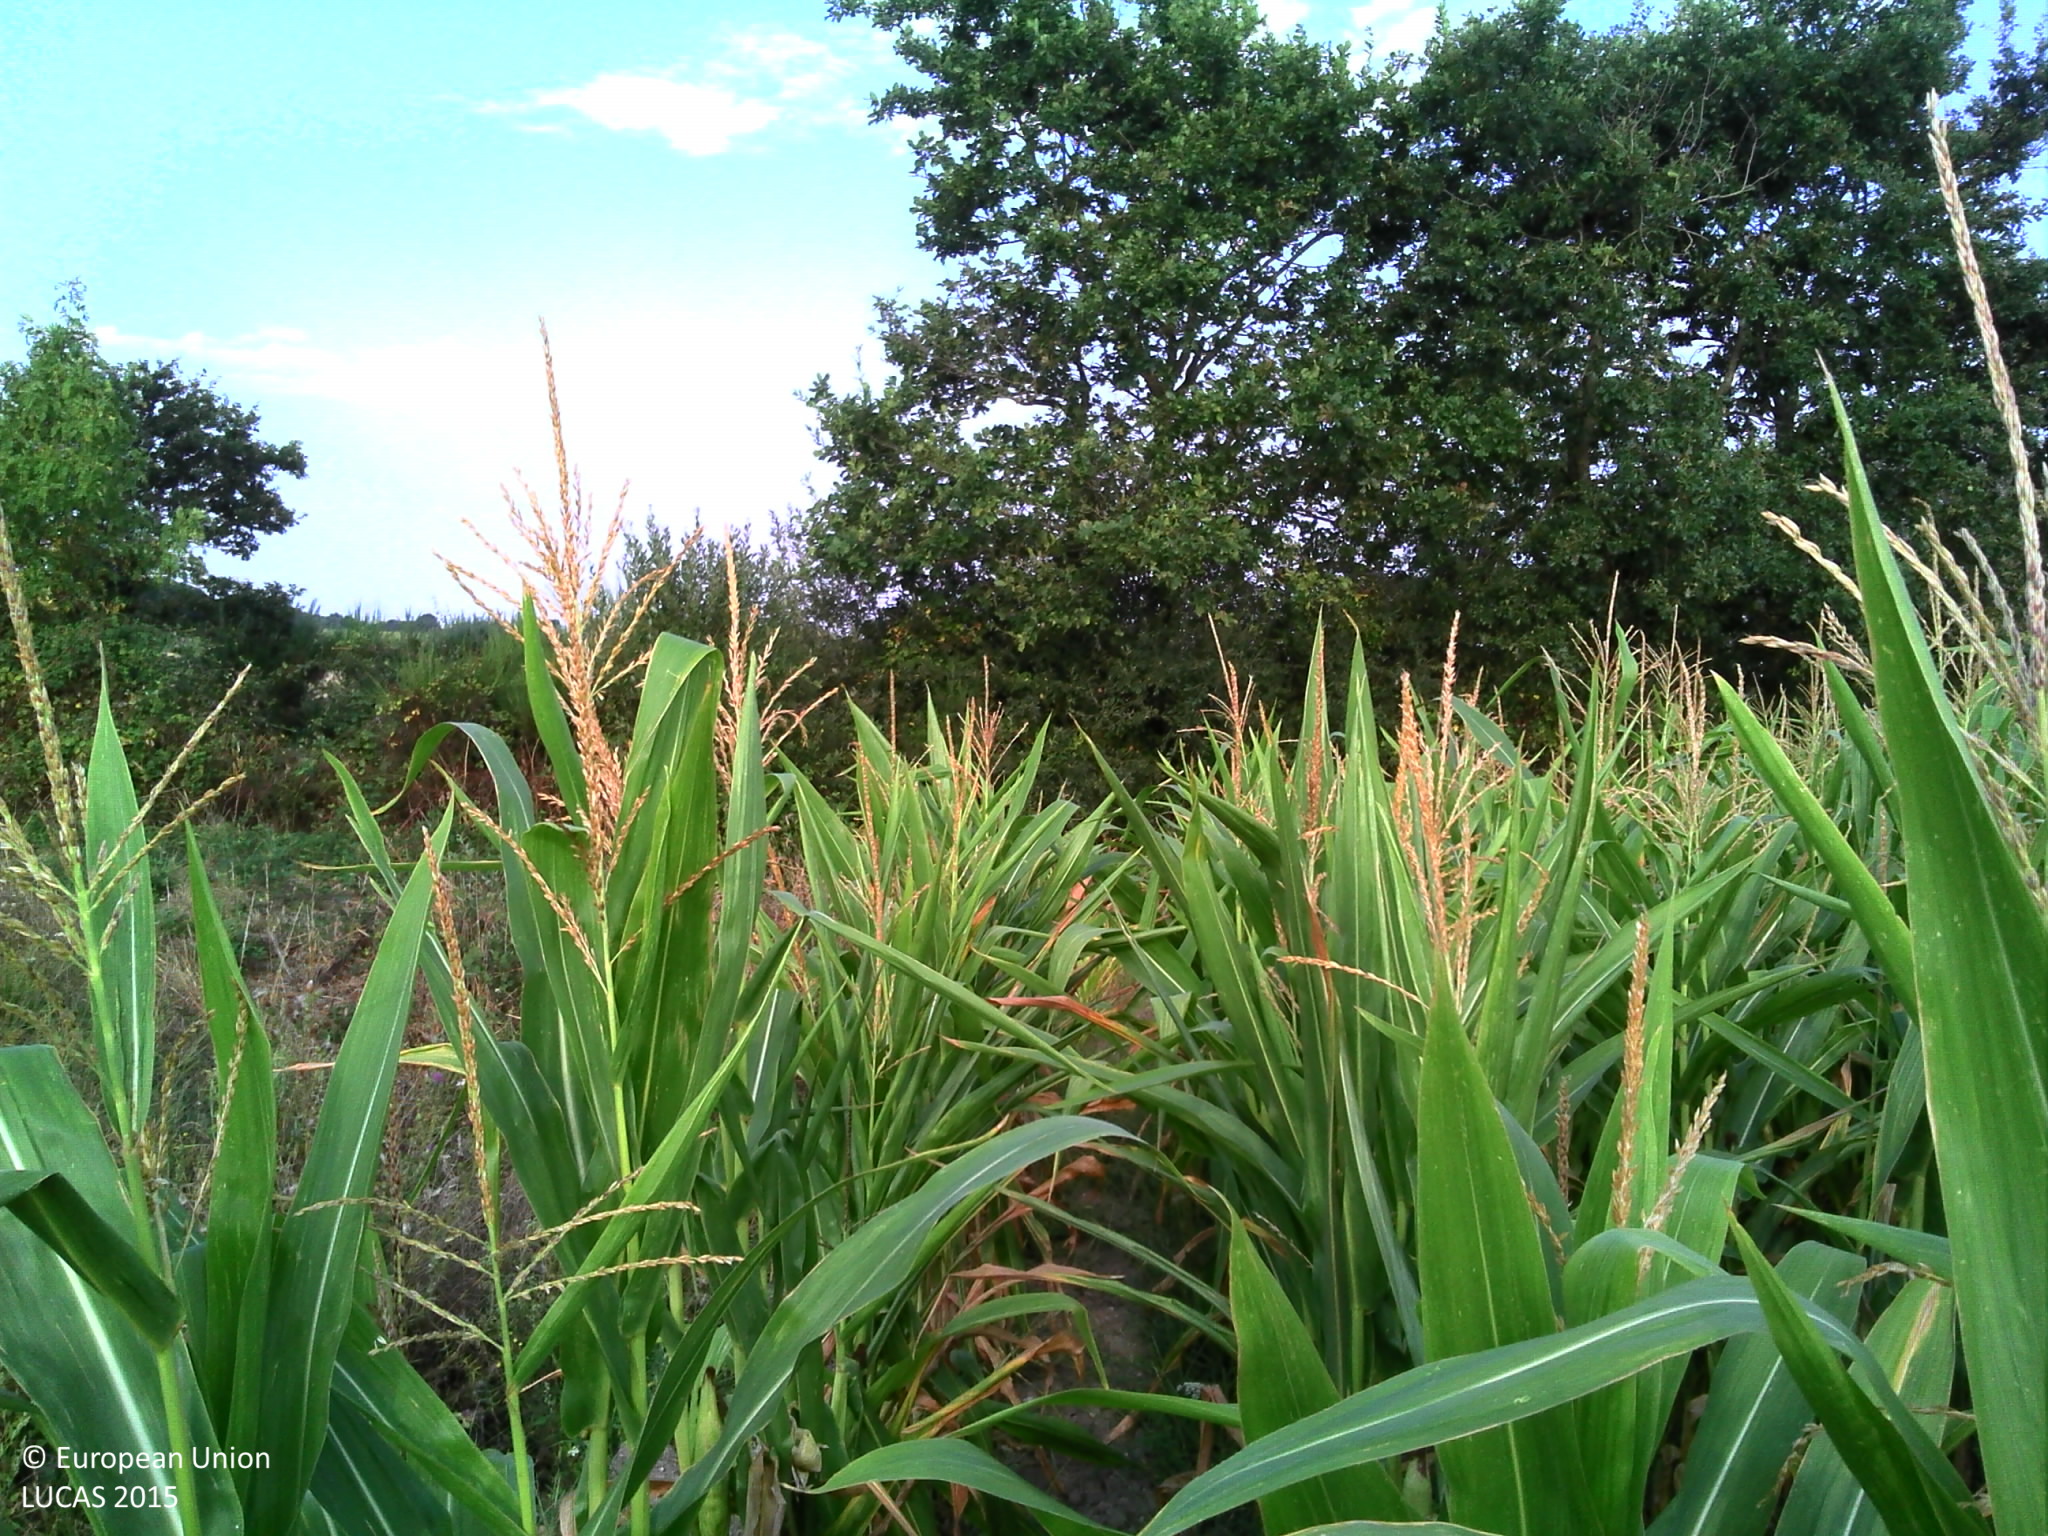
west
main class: Cropland
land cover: Maize
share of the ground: > 75 %
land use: Agriculture (excluding fallow land and kitchen gardens)
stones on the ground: < 10 %
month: August
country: FR
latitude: 46.9618
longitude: -1.6995
